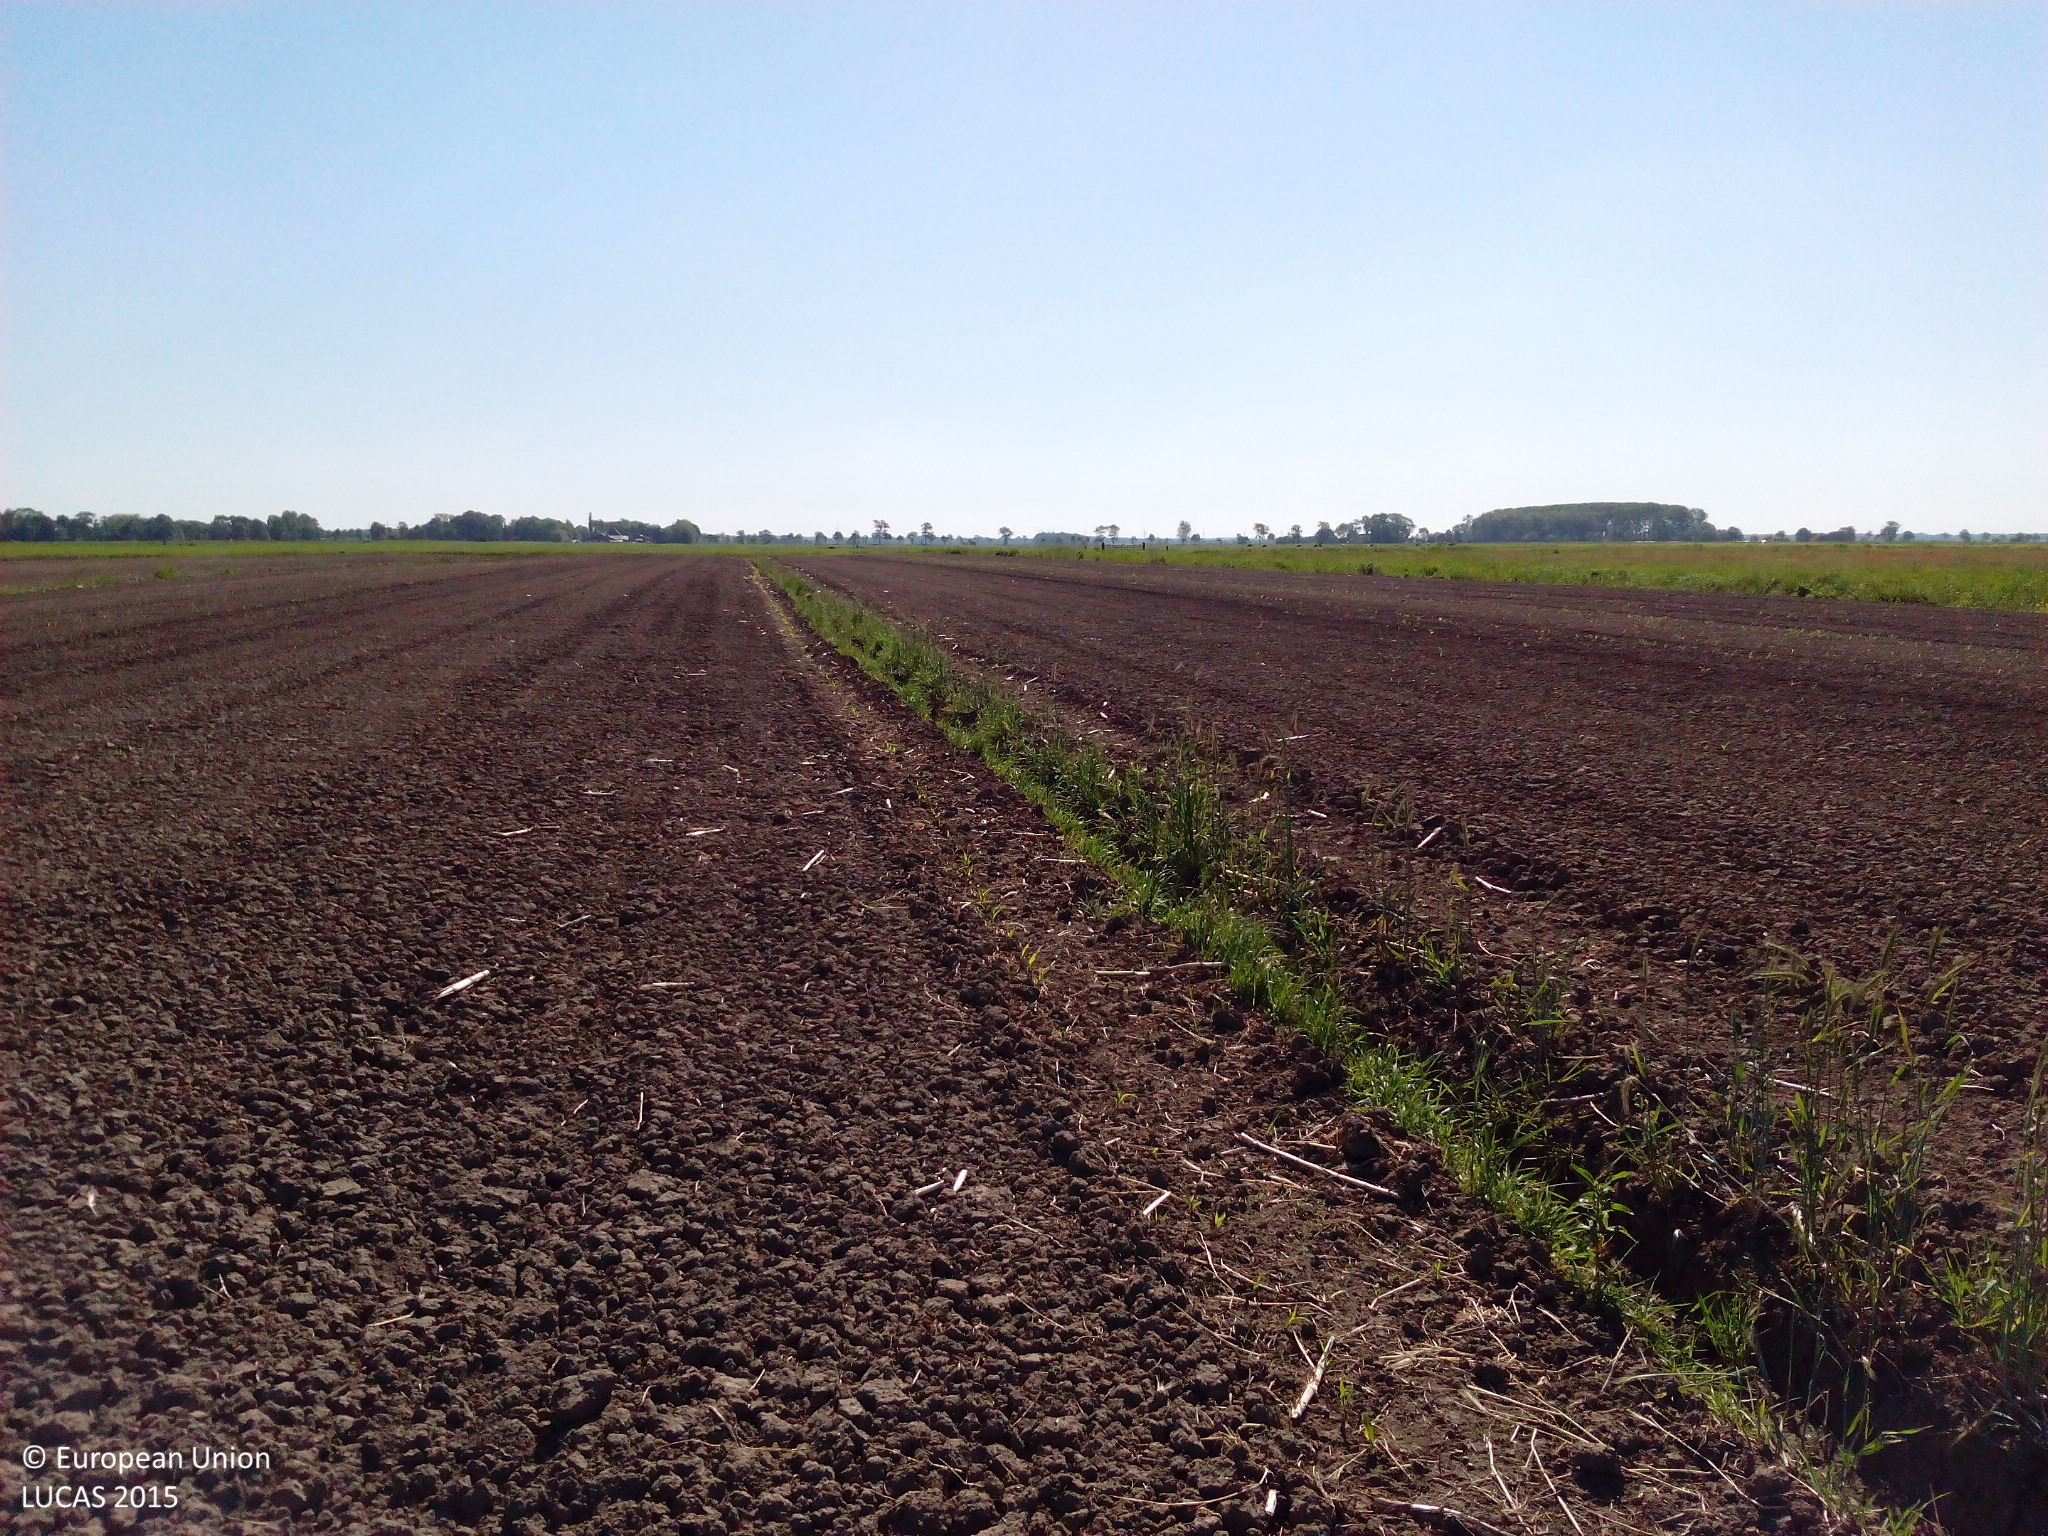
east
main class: Cropland
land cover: Maize
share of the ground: < 10 %
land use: Agriculture (excluding fallow land and kitchen gardens)
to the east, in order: Maize; Ditches and canals; Maize; Ditches and canals; Grassland without tree/shrub cover
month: June
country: DE
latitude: 53.4108
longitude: 8.5113
